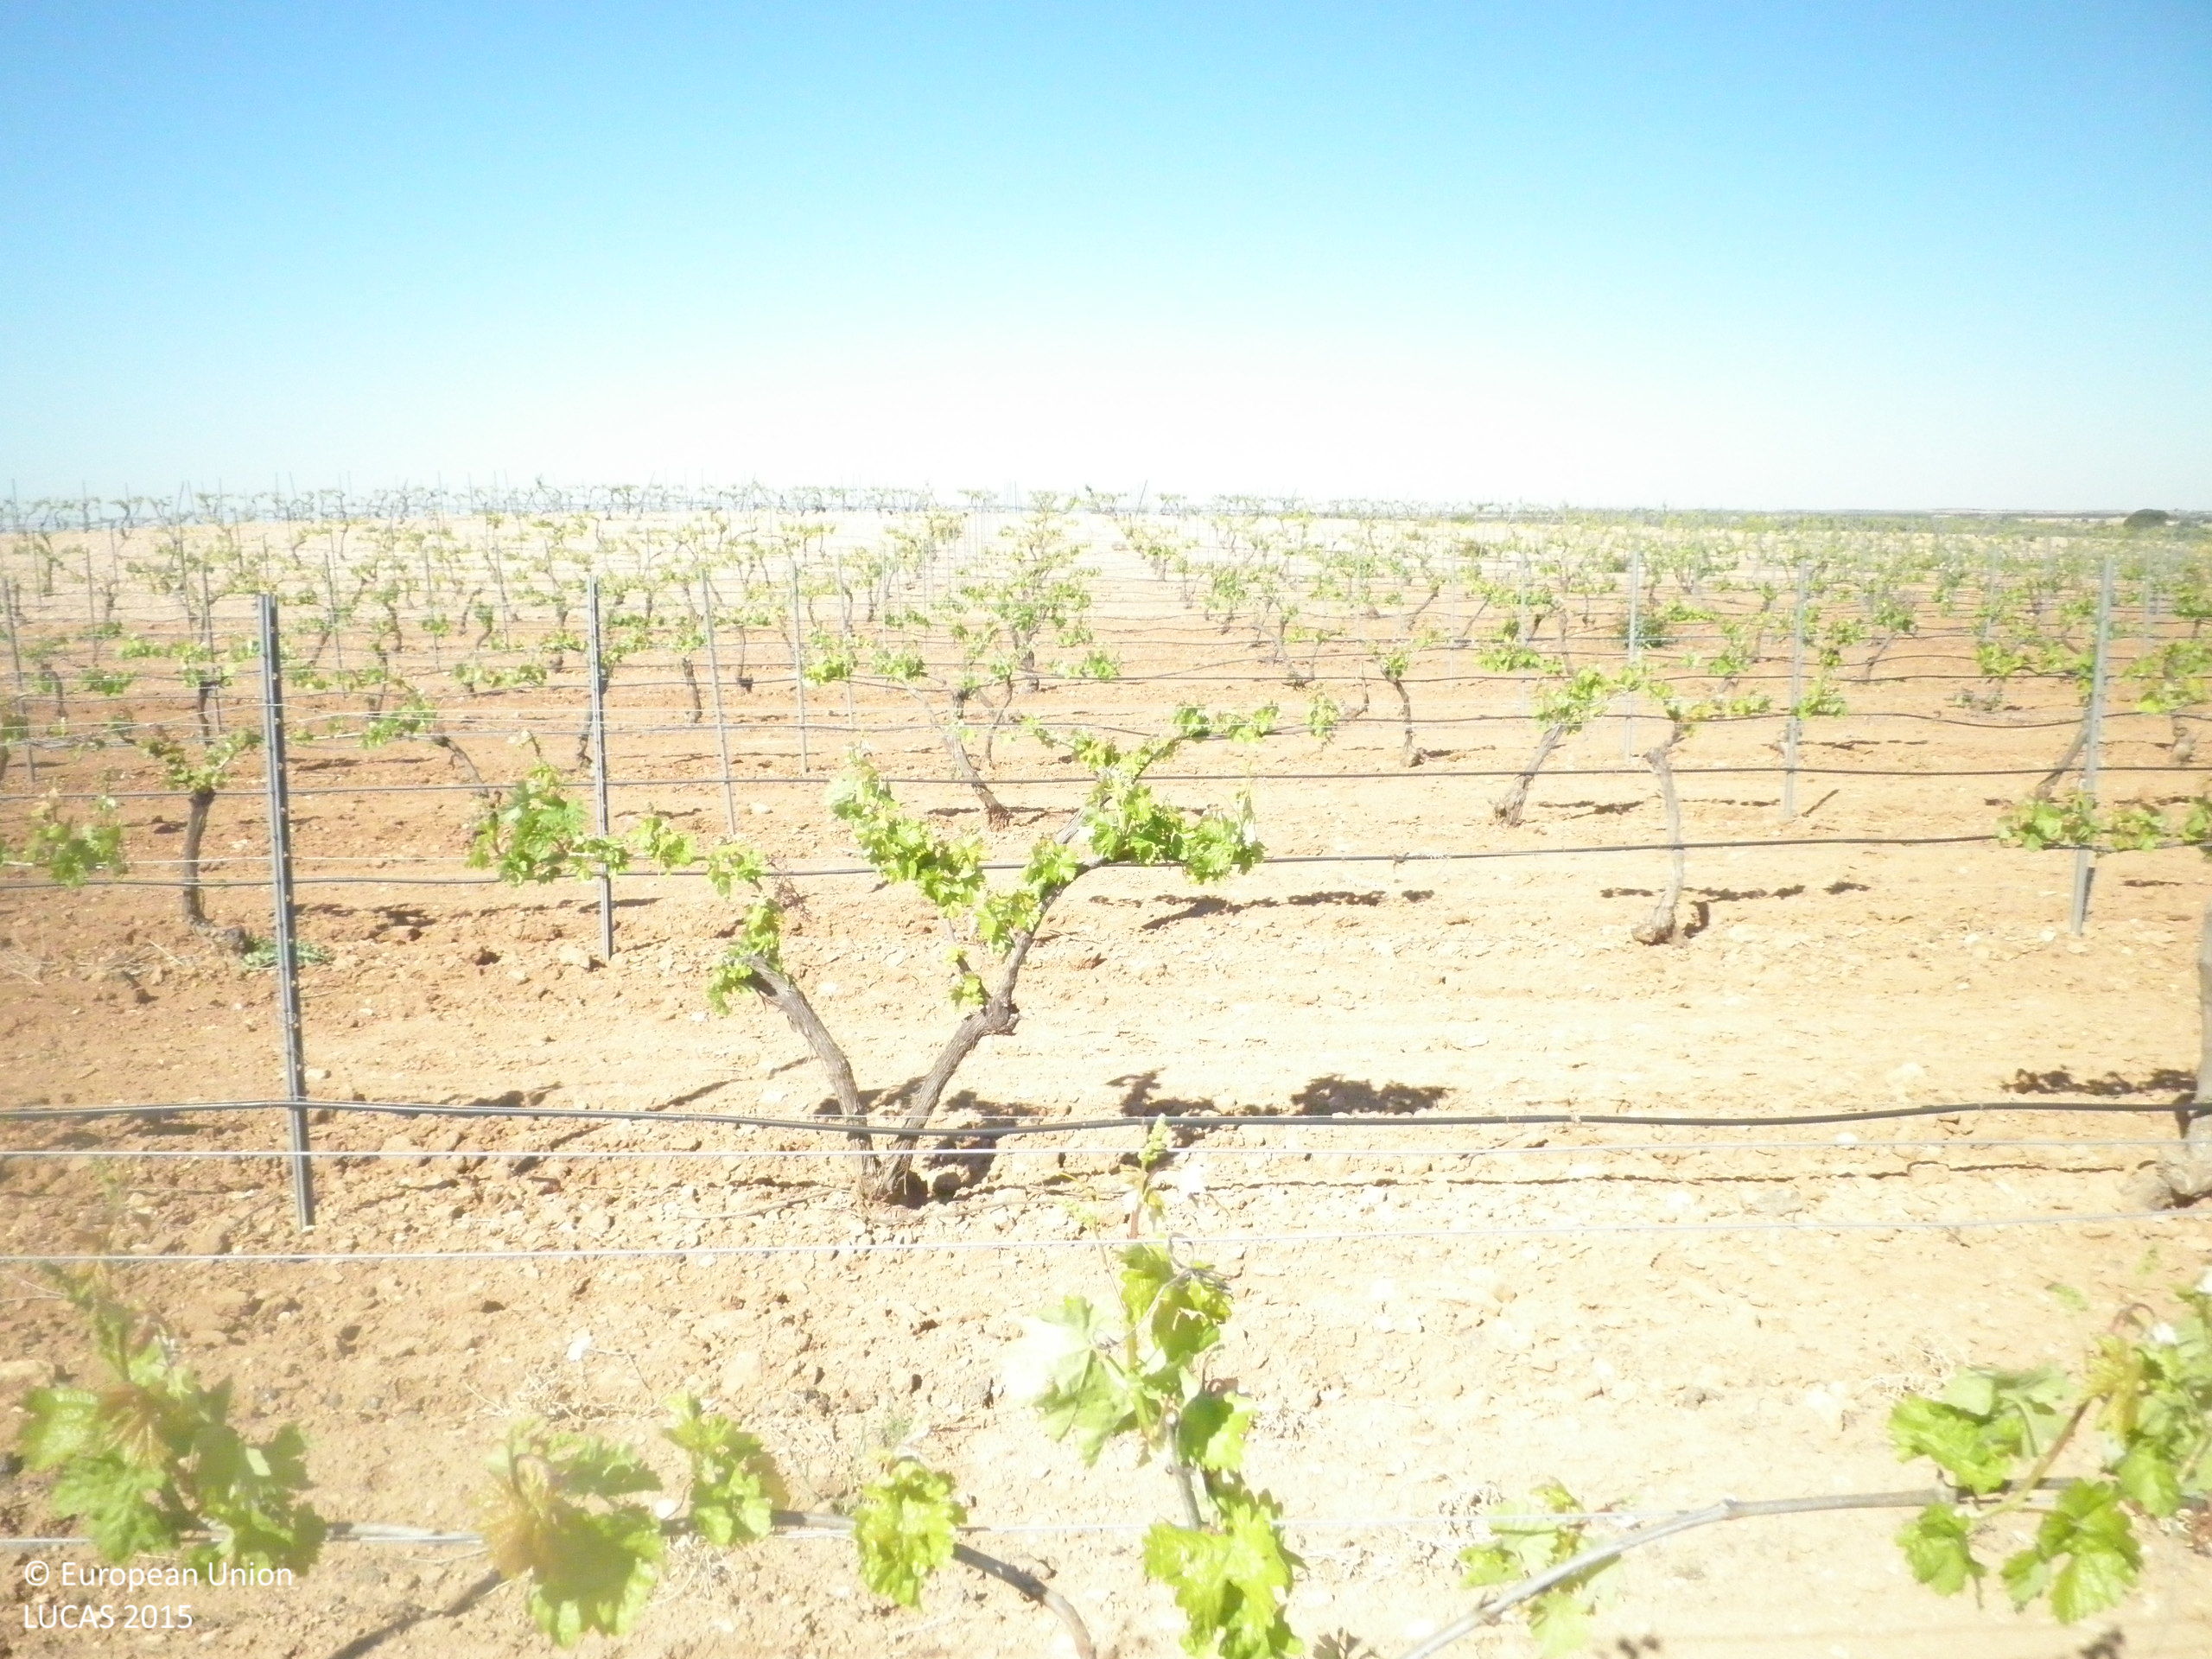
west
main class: Cropland
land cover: Vineyards
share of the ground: < 10 %
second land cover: Other bare soil
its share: > 75 %
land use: Agriculture (excluding fallow land and kitchen gardens)
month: May
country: ES
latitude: 39.4664
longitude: -2.7650
